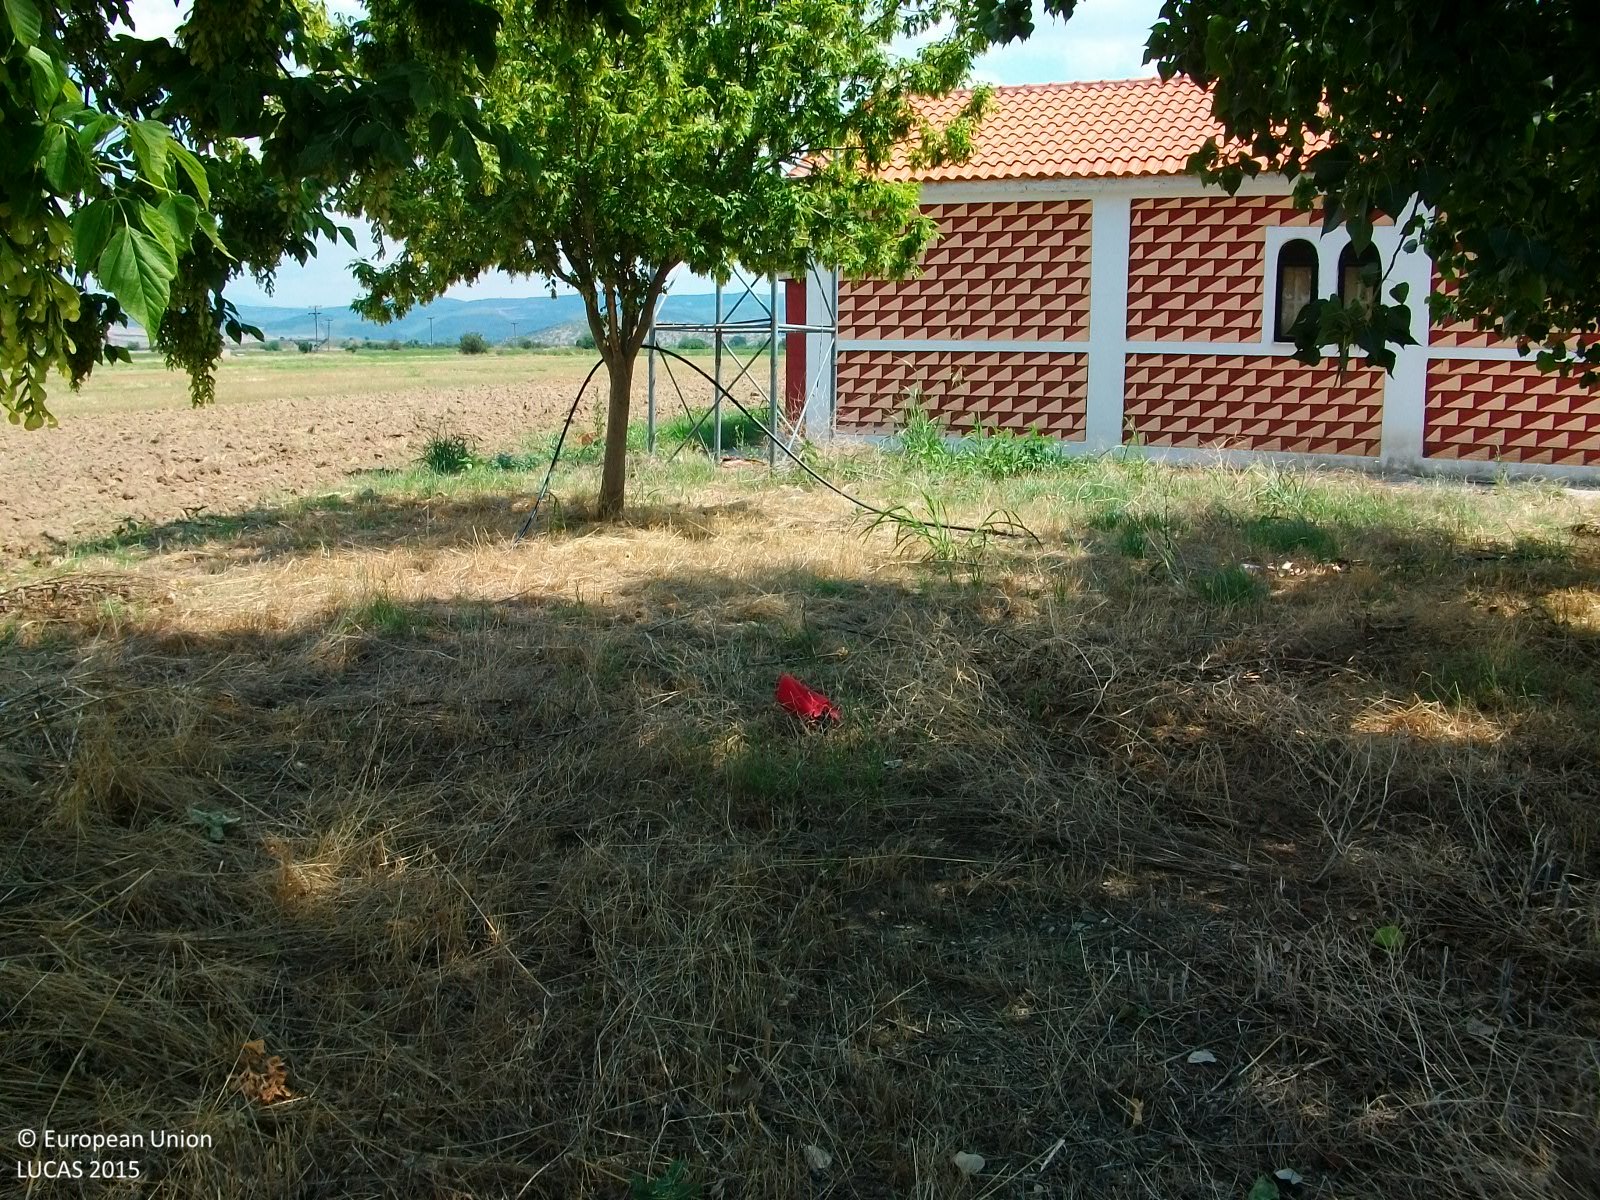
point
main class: Grassland
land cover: Grassland with sparse tree/shrub cover
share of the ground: > 75 %
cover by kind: herbaceous plants 90 %, broadleaved forest trees 5 %, unconsolidated bare surface 5 %
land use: Community services
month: July
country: GR
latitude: 39.2016
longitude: 22.2691
